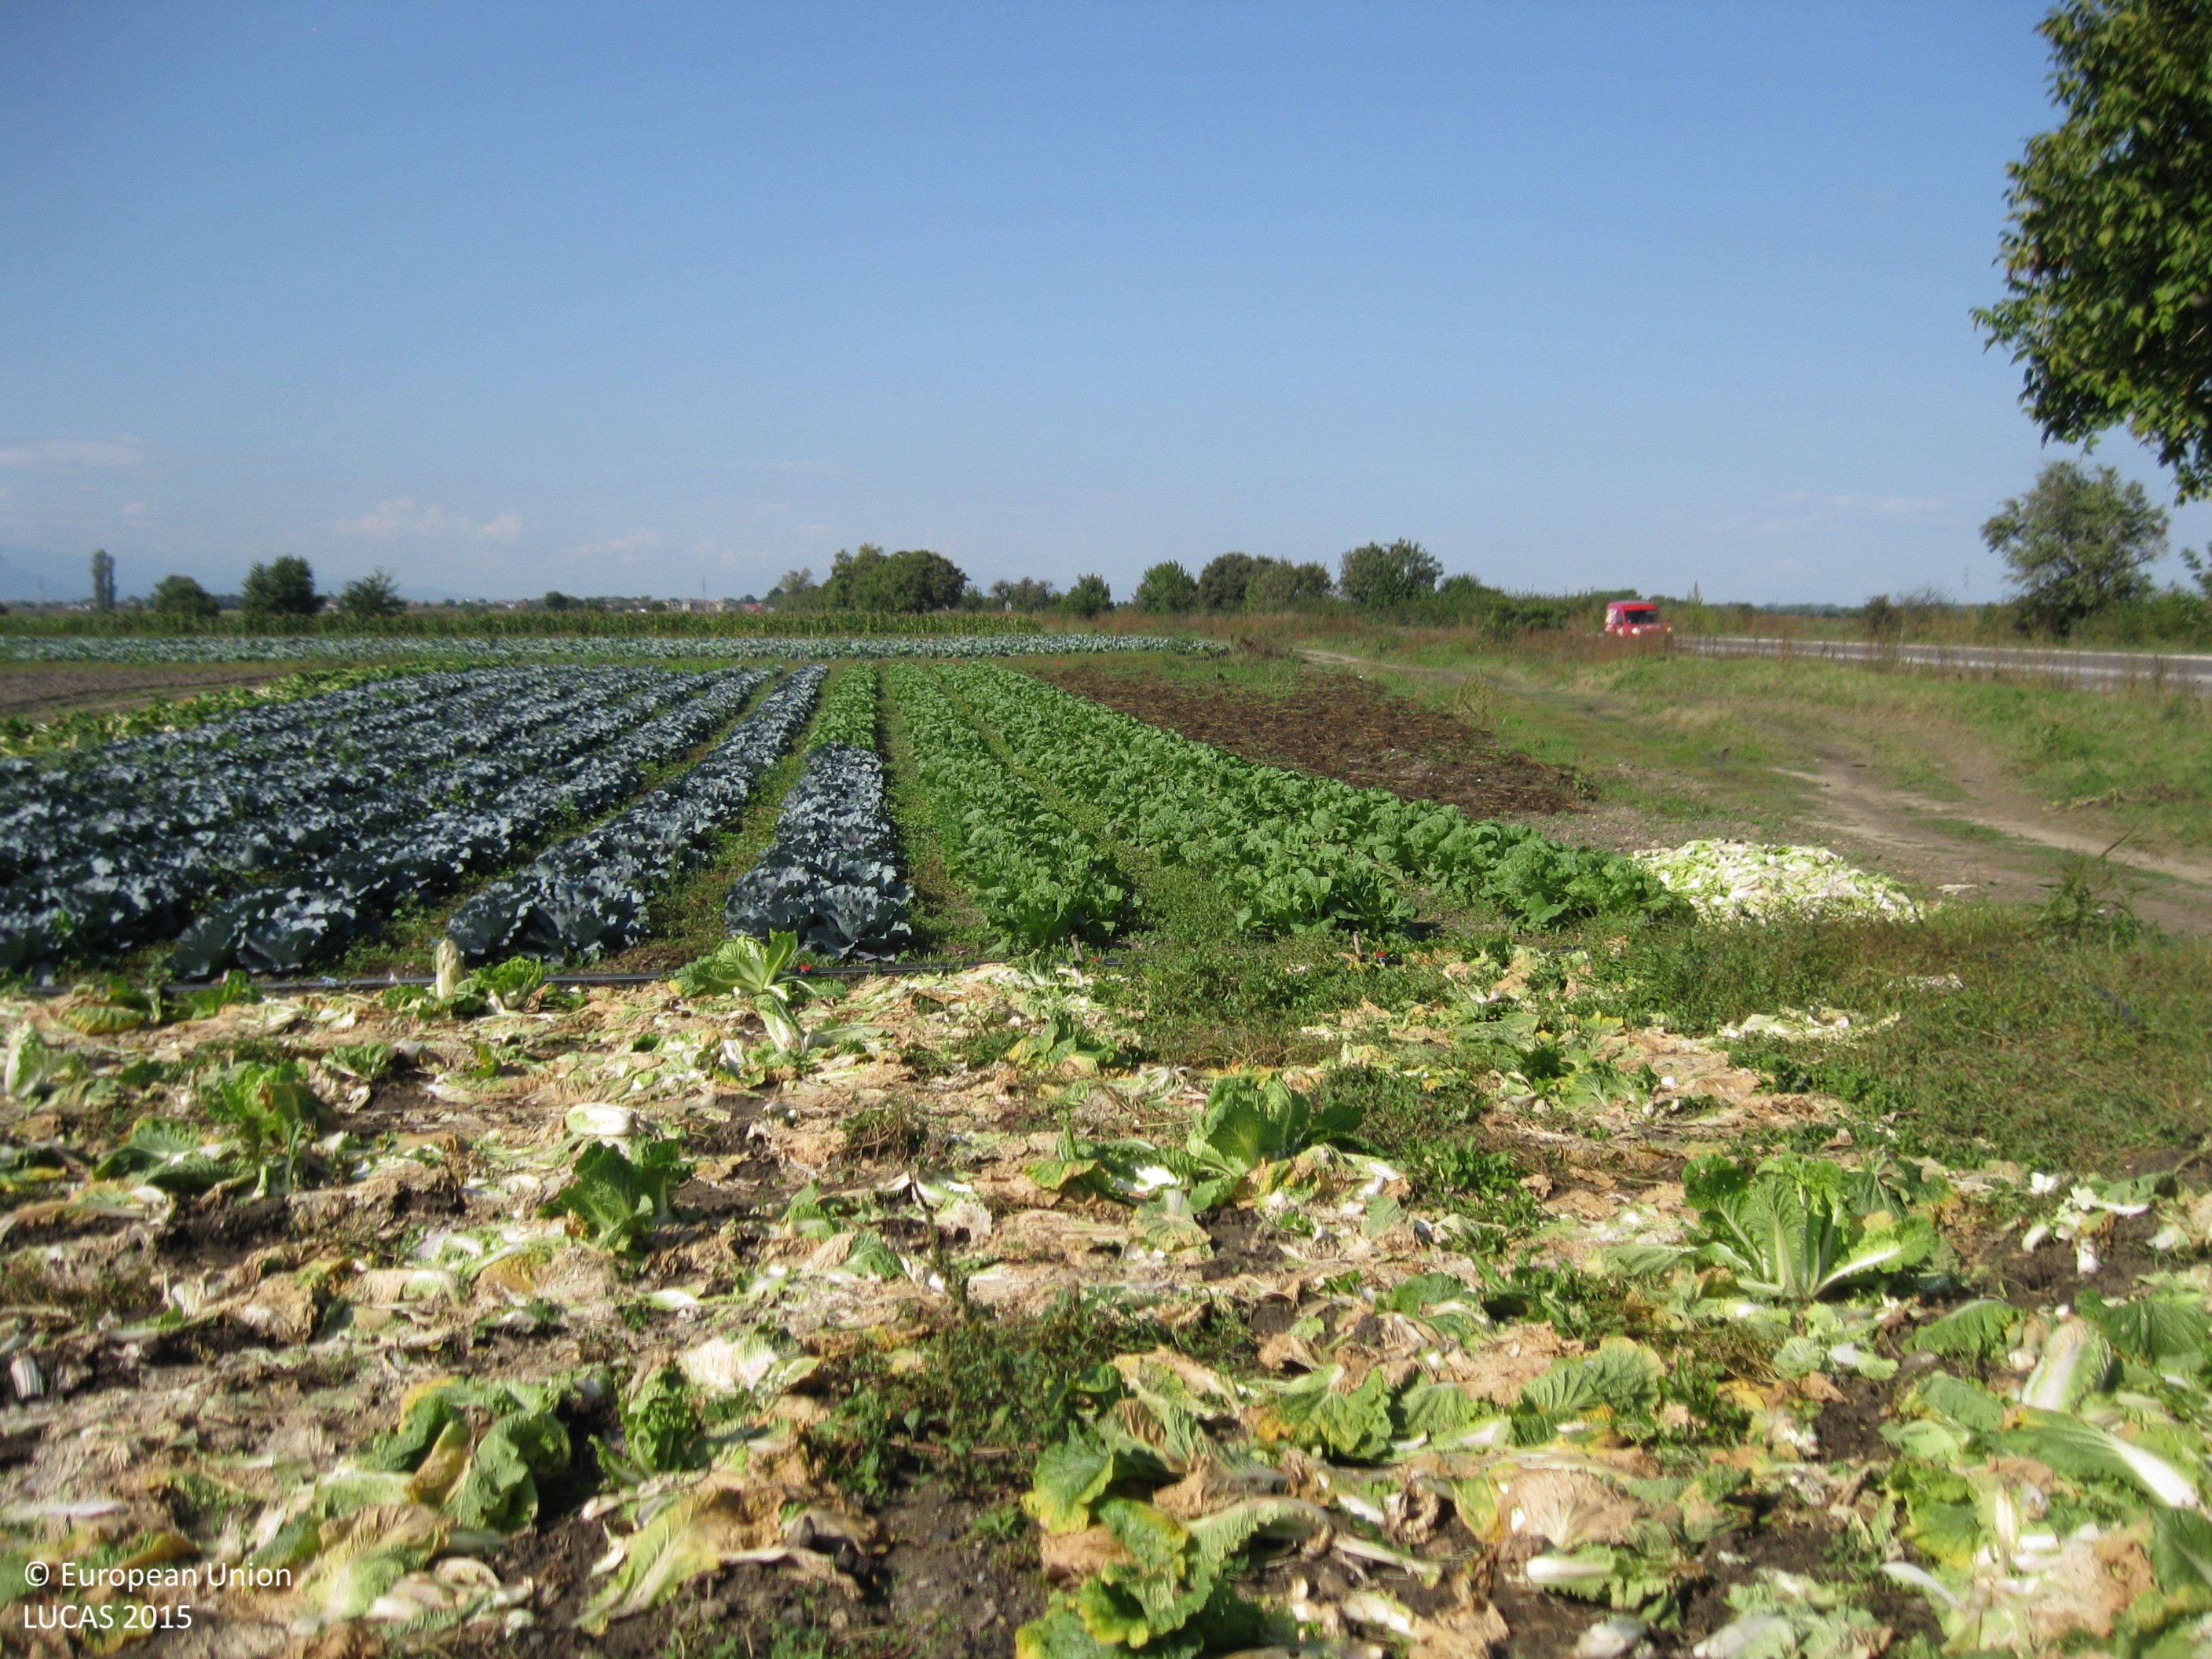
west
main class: Cropland
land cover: Other fresh vegetables
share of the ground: > 75 %
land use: Agriculture (excluding fallow land and kitchen gardens)
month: October
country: BG
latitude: 42.1388
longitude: 24.9737
